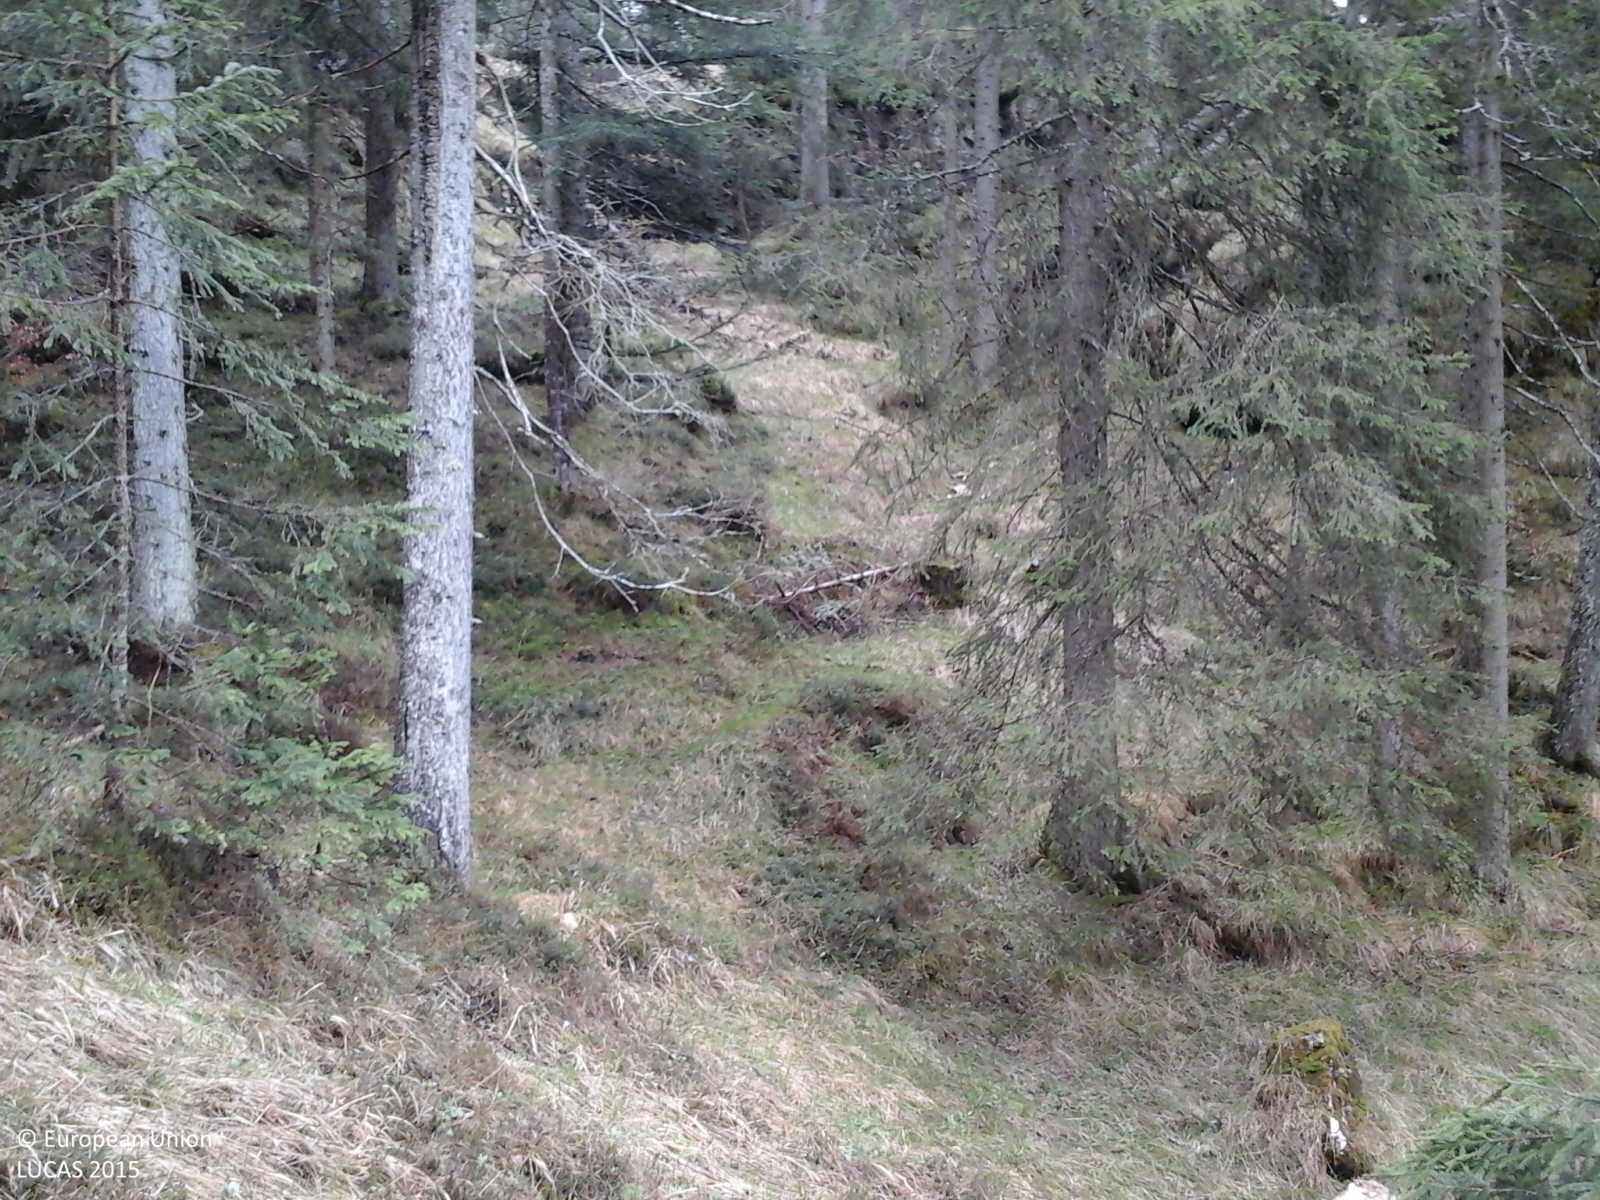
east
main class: Woodland
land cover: Spruce dominated coniferous woodland
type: alpine coniferous forest
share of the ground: > 75 %
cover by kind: coniferous forest trees 100 %
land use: Forestry
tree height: > 5 m
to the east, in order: Spruce dominated coniferous woodland; Tracks; Spruce dominated coniferous woodland; Paved roads, cycling and walking lanes; Spruce dominated coniferous woodland; Paved roads, cycling and walking lanes; Spruce dominated coniferous woodland
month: May
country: IT
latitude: 46.5073
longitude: 11.1324
